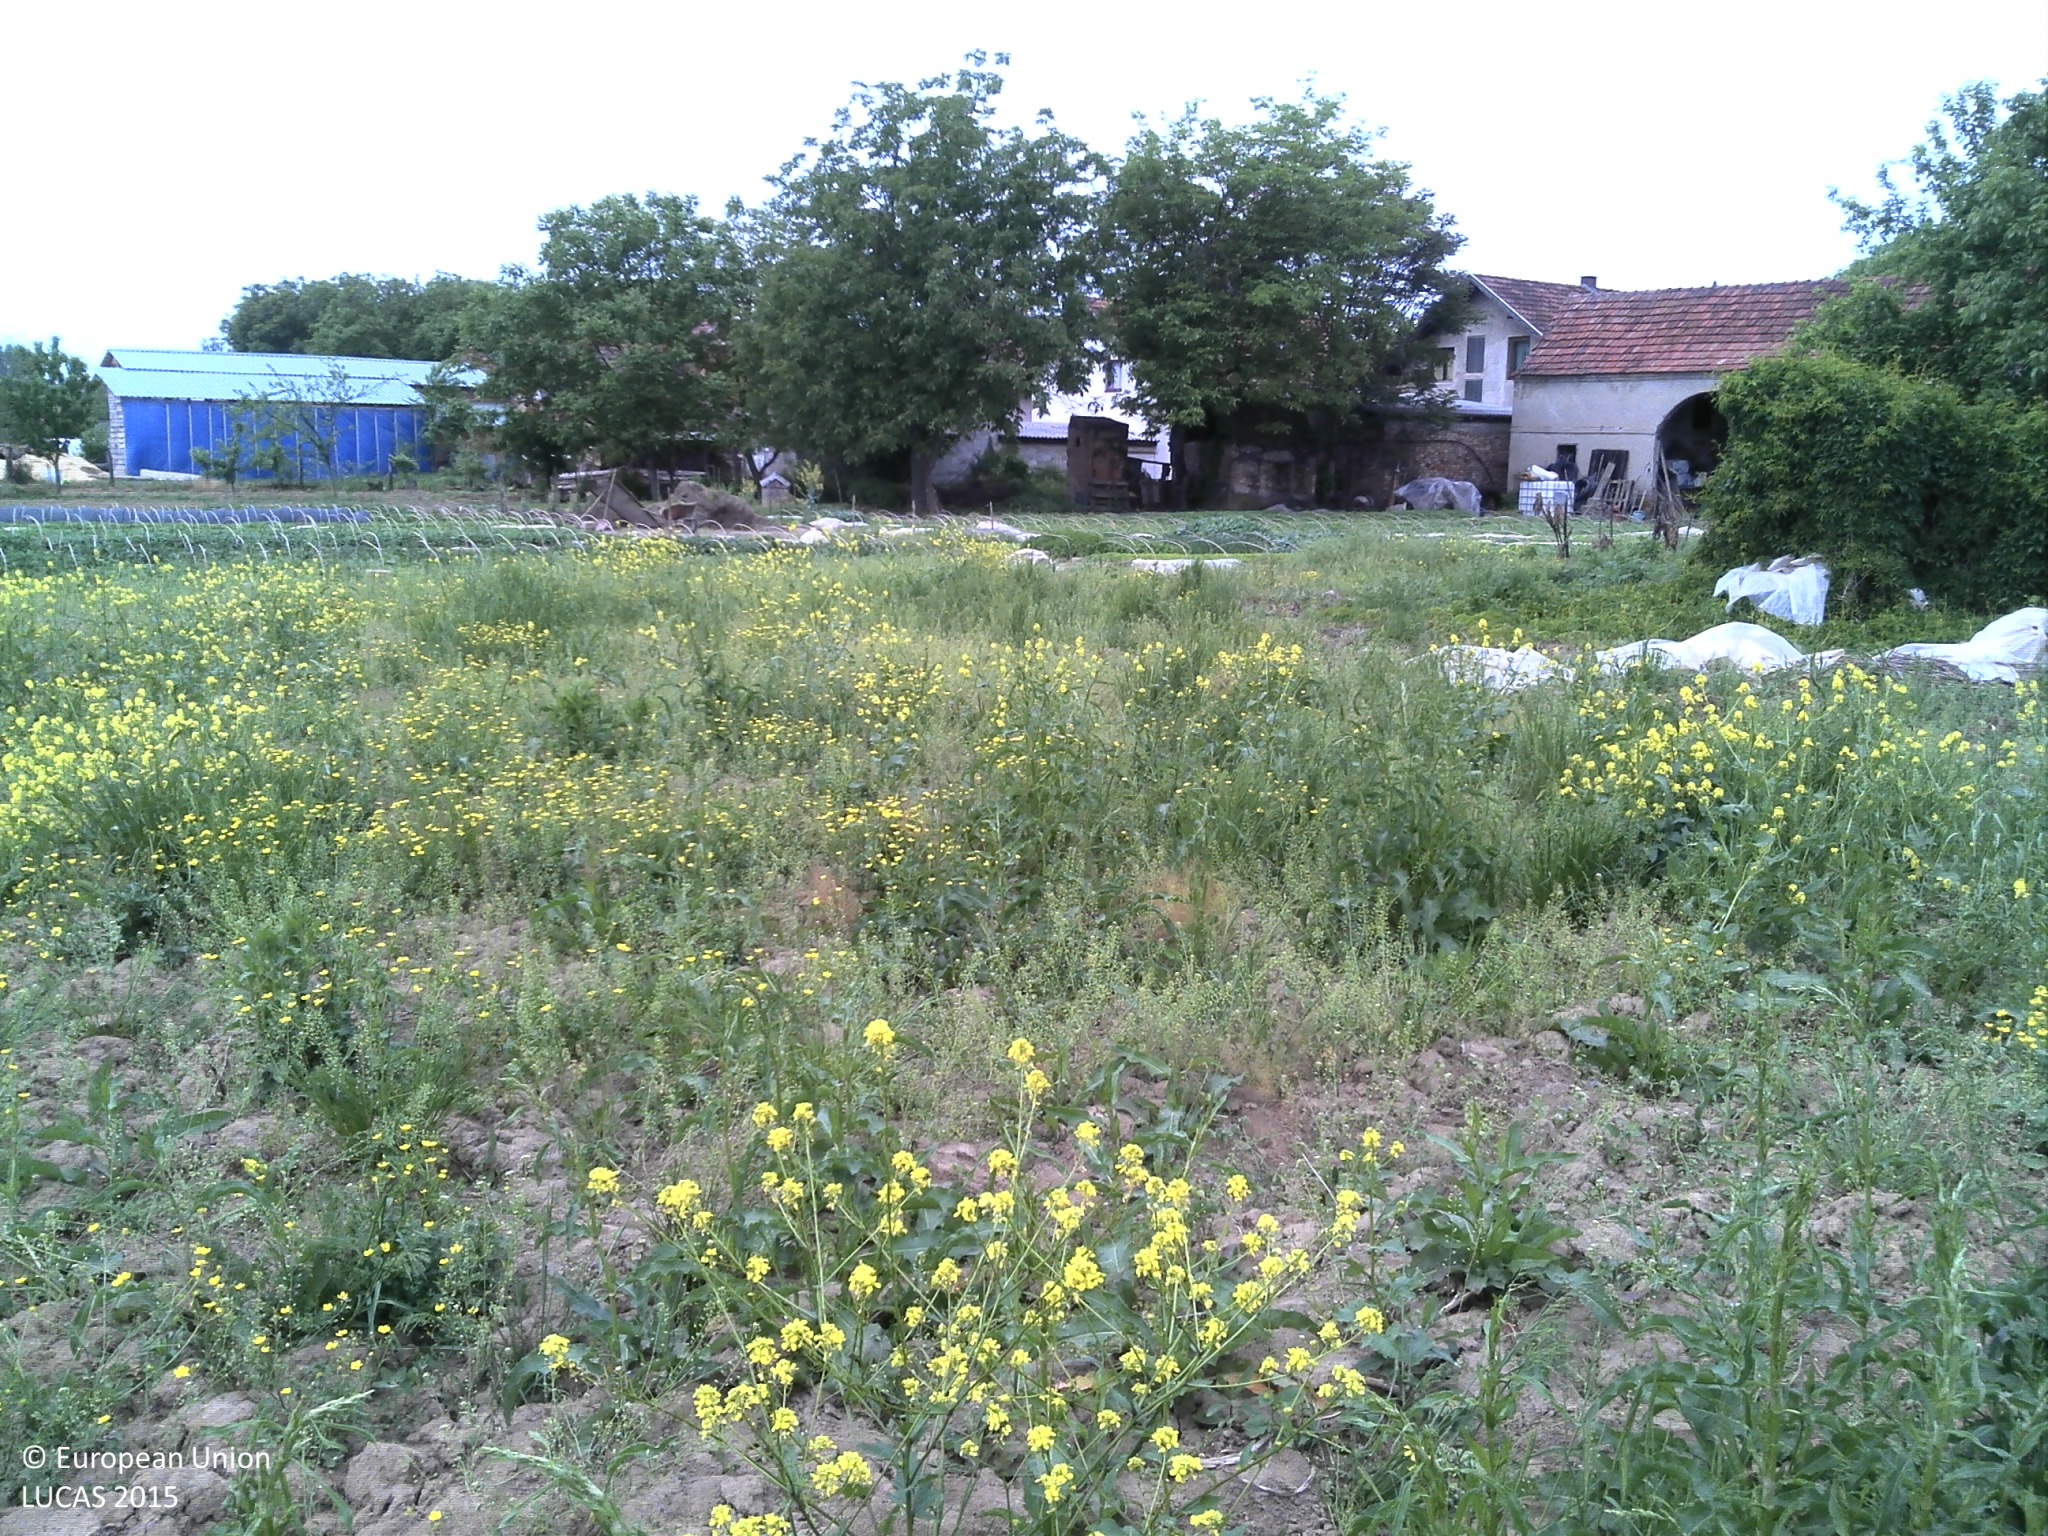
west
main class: Grassland
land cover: Spontaneously vegetated surfaces
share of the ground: > 75 %
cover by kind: herbaceous plants 100 %
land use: Fallow land
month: May
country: HR
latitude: 45.0725
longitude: 18.4765
